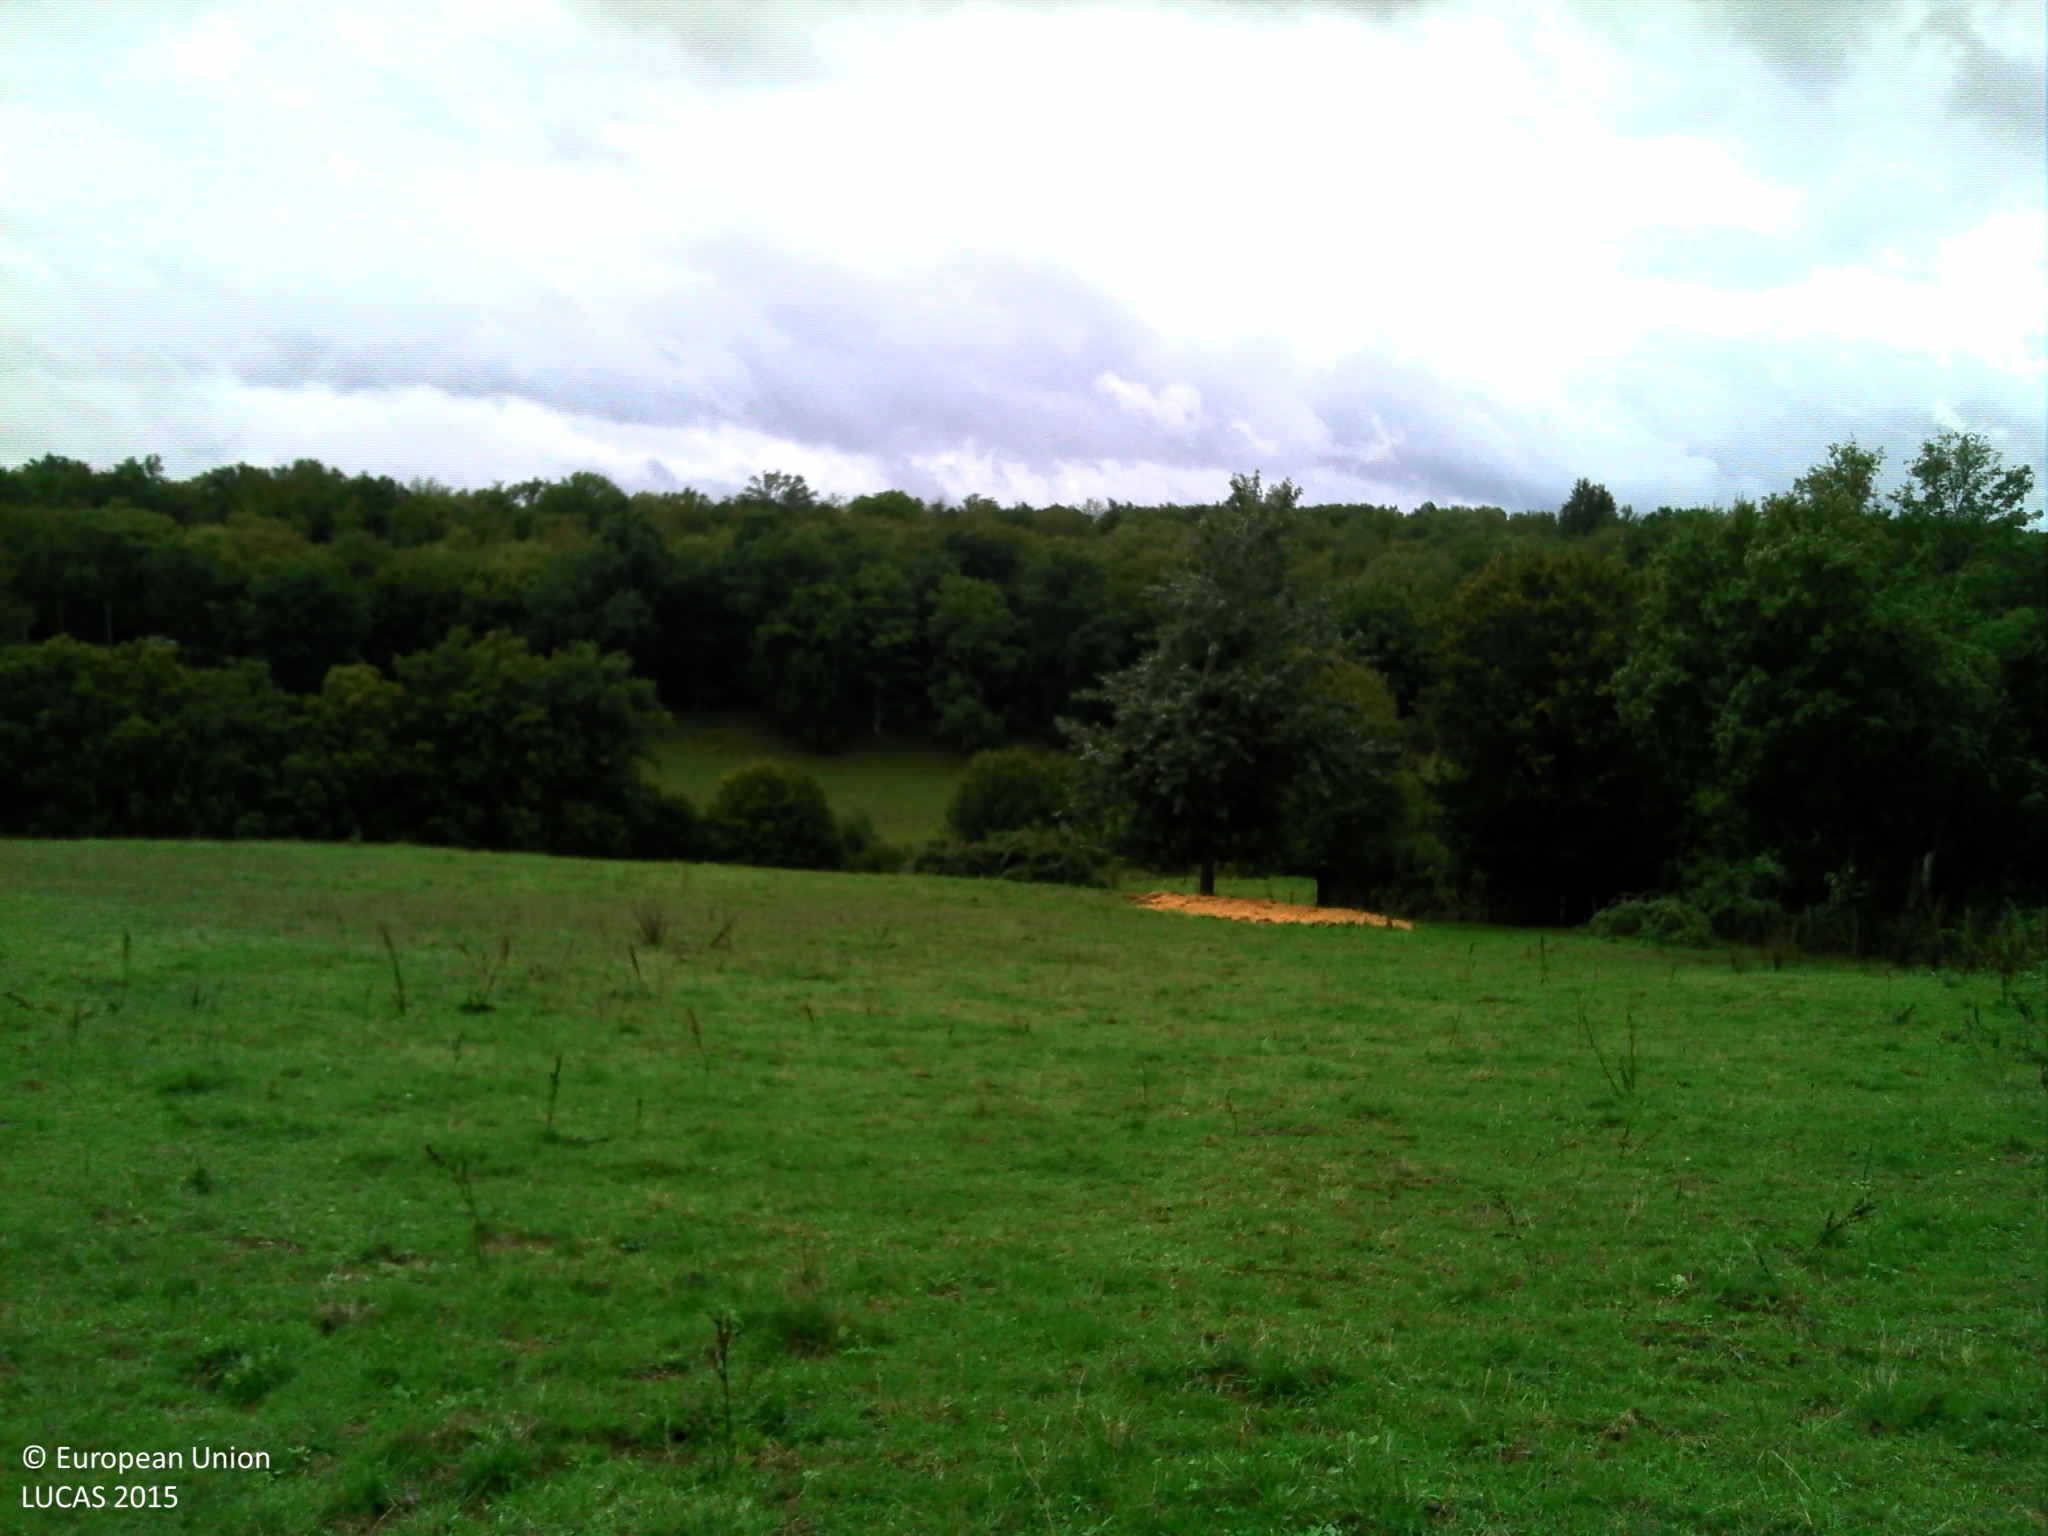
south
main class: Grassland
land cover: Grassland without tree/shrub cover
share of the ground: > 75 %
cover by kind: herbaceous plants 100 %
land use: Agriculture (excluding fallow land and kitchen gardens)
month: September
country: FR
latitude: 47.3554
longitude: 4.3194
